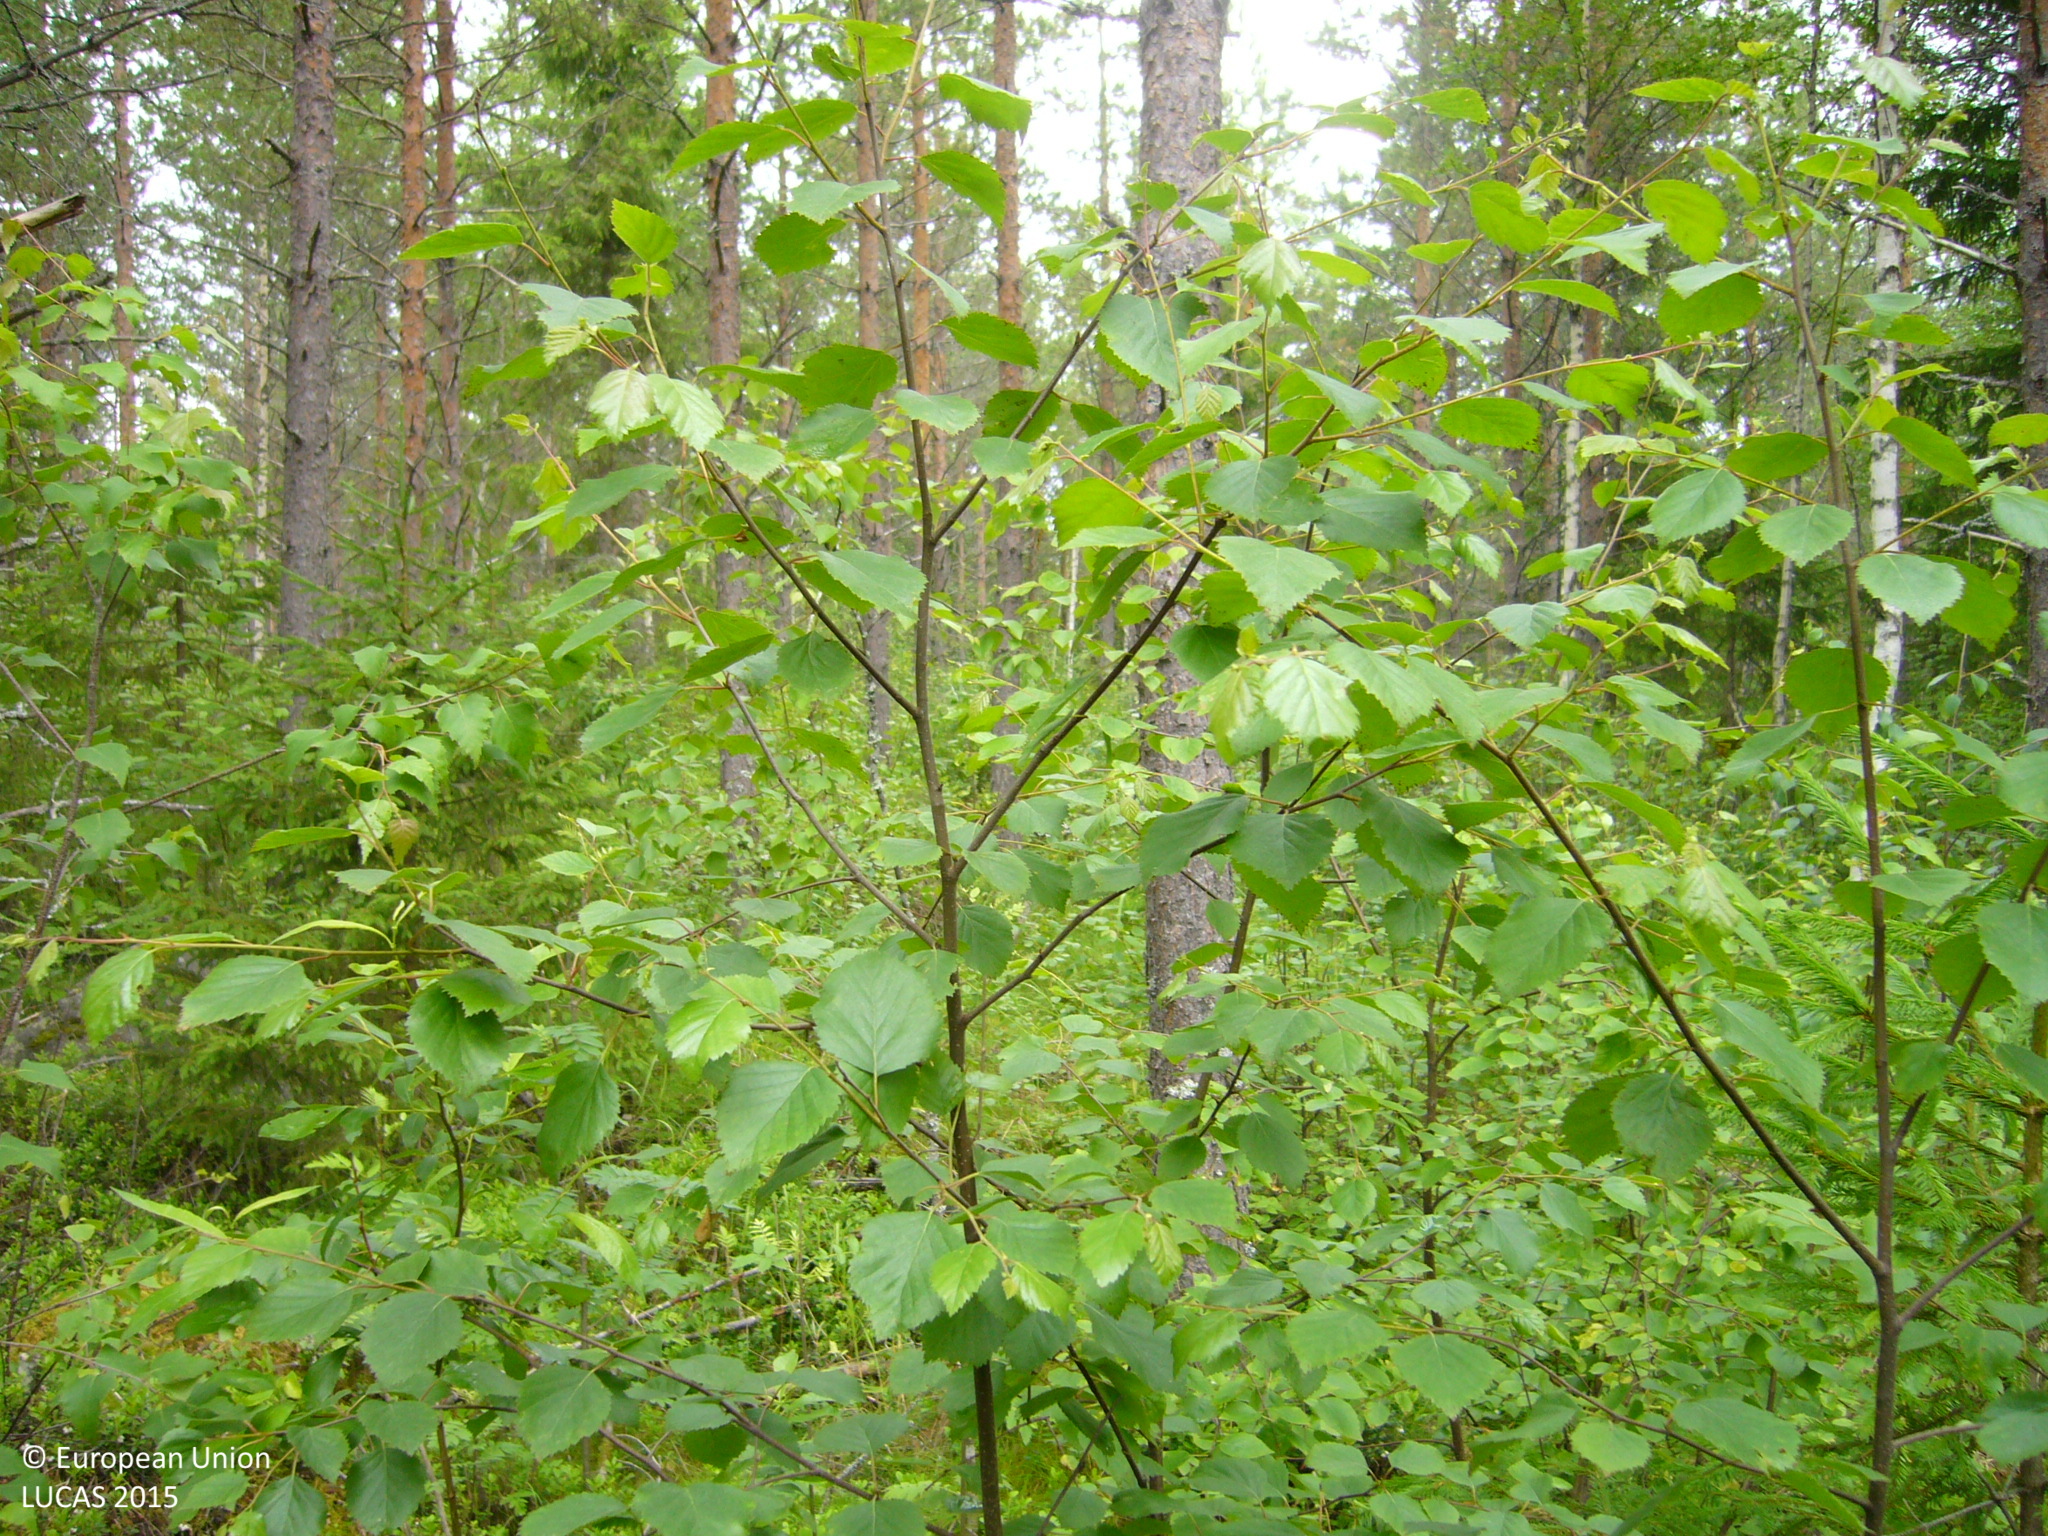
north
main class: Woodland
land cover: Pine dominated mixed woodland
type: boreal forest
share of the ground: > 75 %
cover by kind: coniferous forest trees 50 %, broadleaved forest trees 25 %, shrubs 25 %
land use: Forestry
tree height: > 5 m
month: July
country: FI
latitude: 63.4101
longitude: 25.2966
